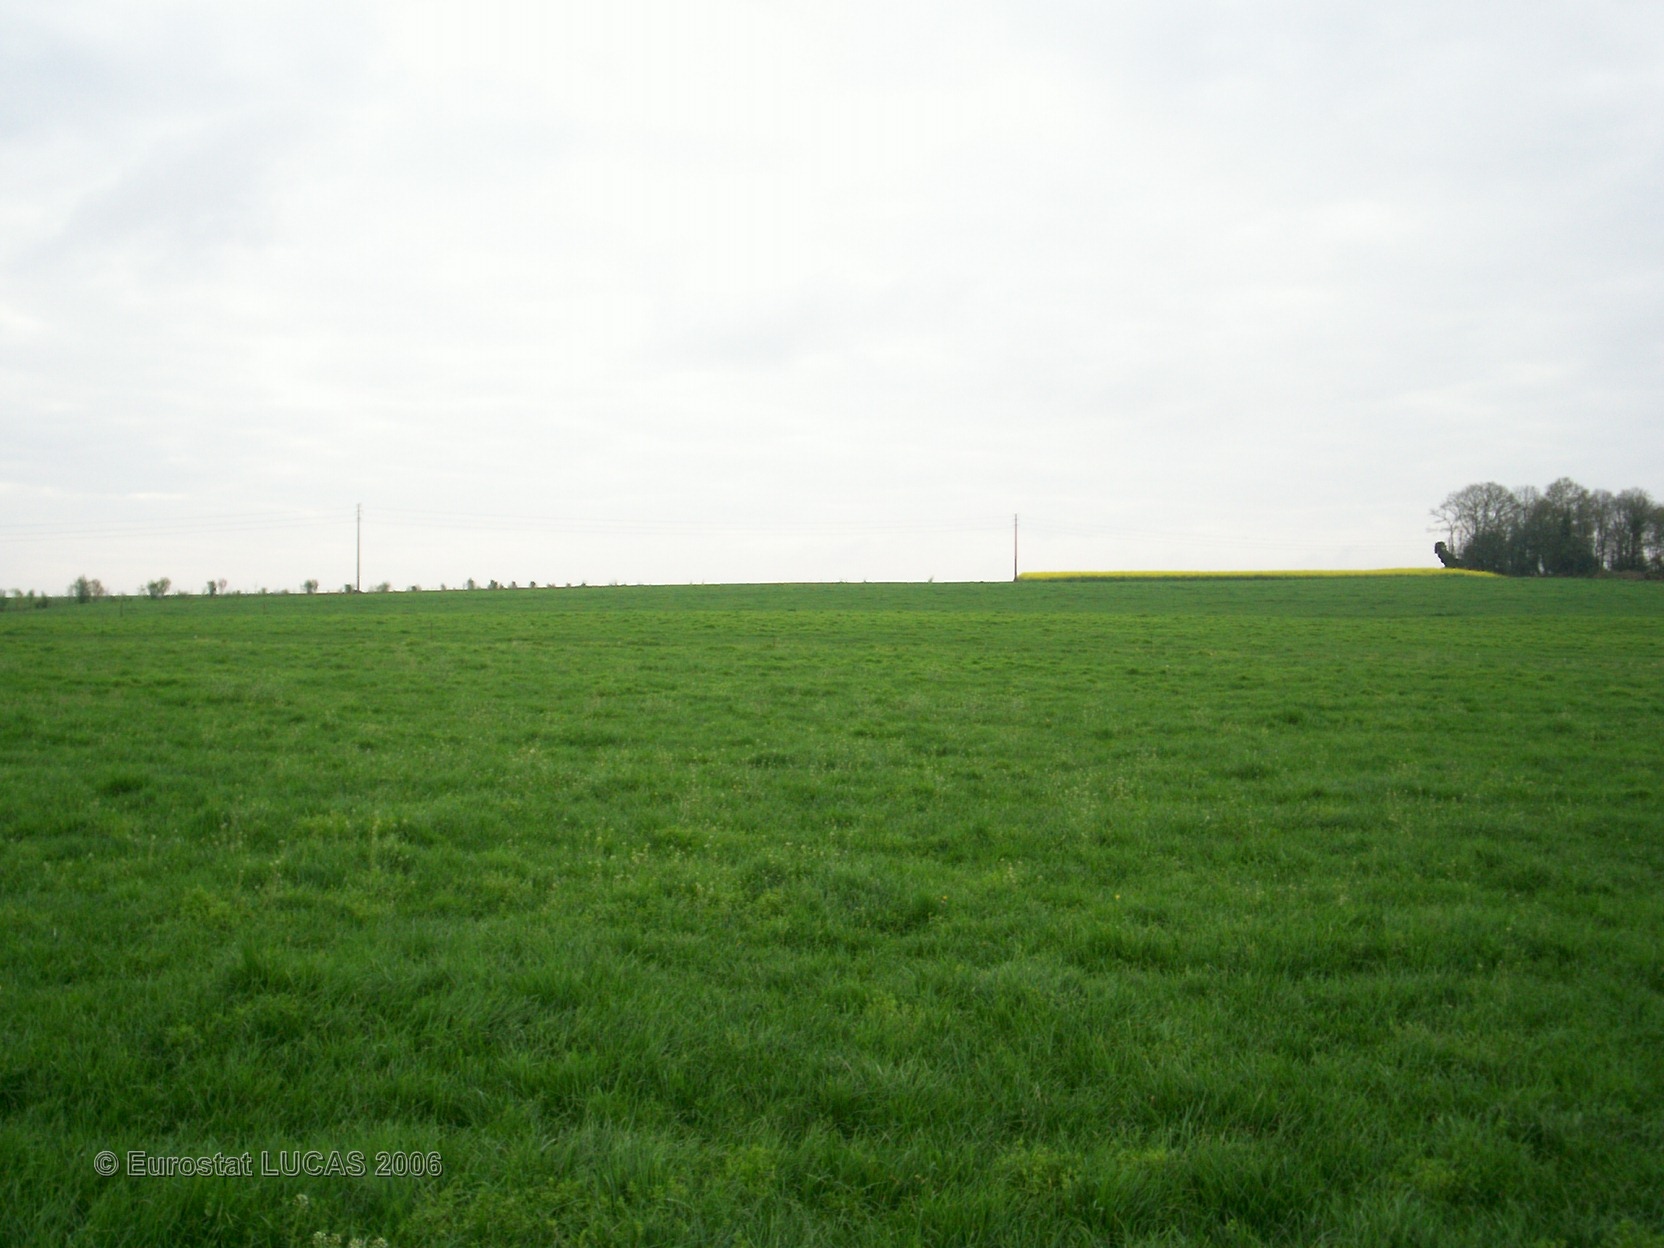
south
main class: Grassland
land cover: Grassland without tree/shrub cover
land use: Agriculture (excluding fallow land and kitchen gardens)
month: April
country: FR
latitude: 47.9788
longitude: -2.3694
